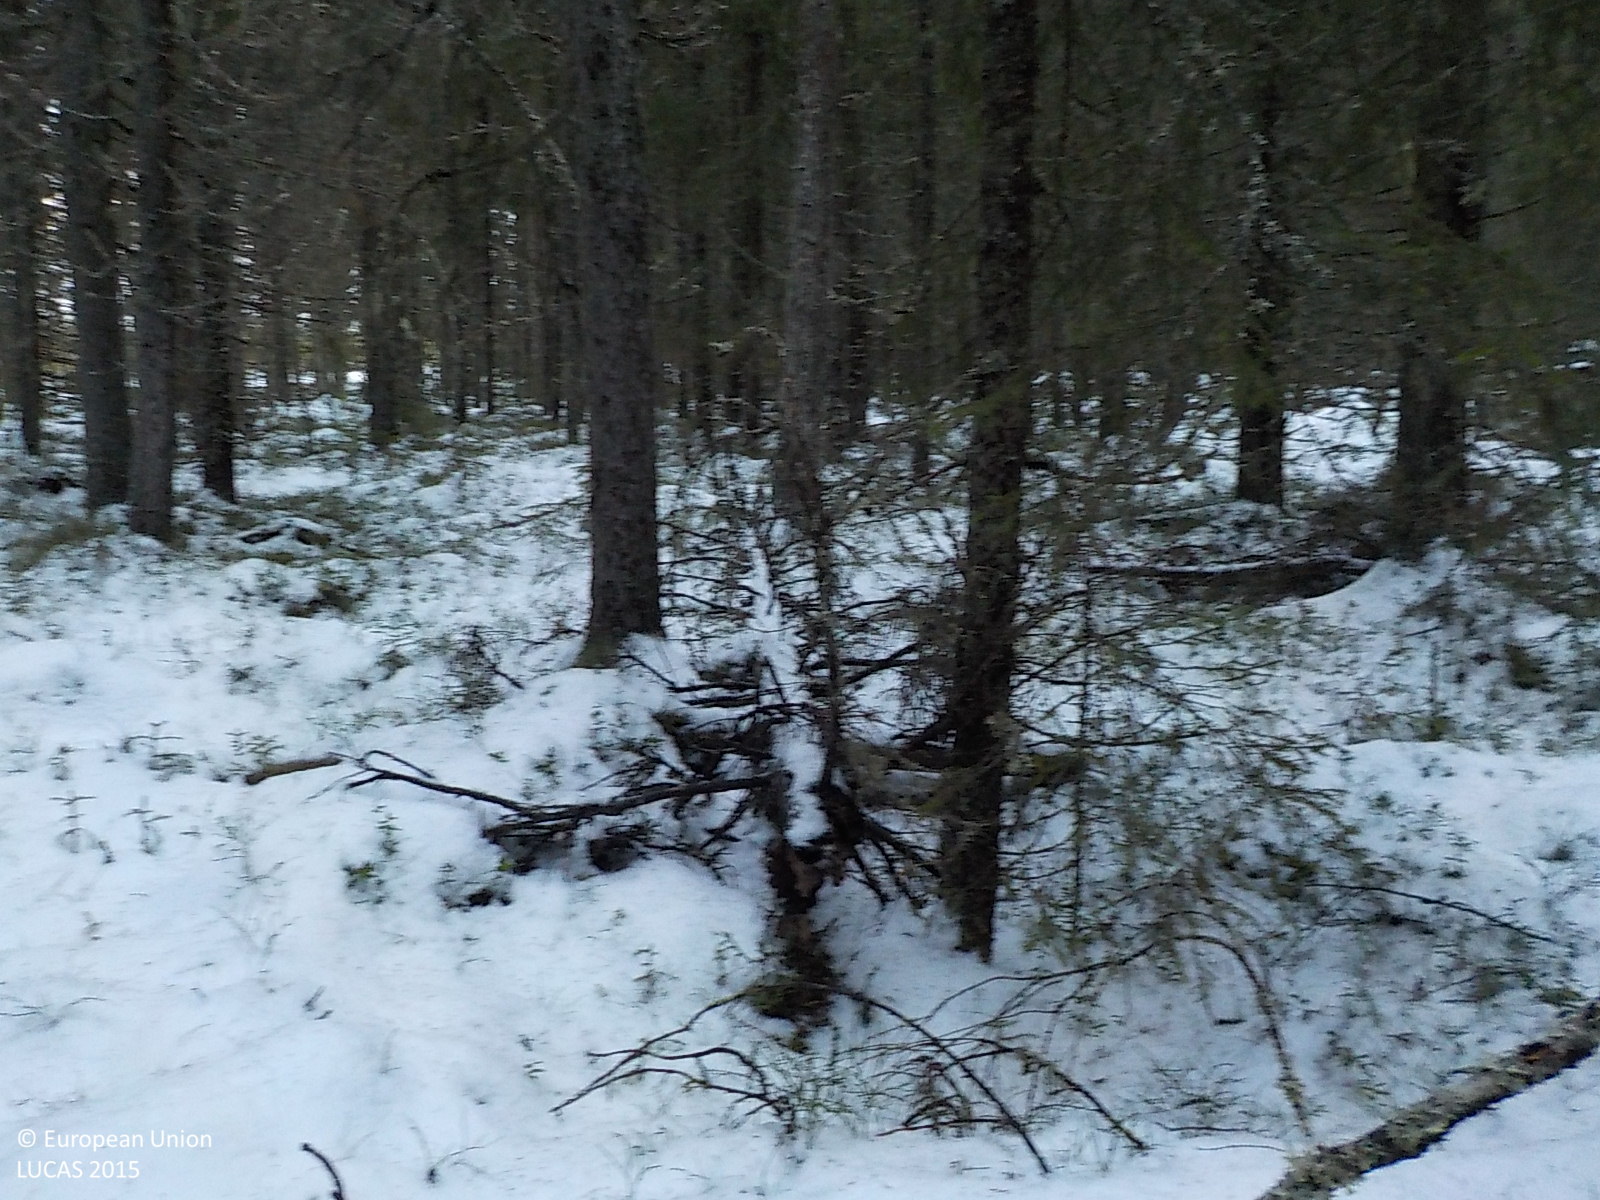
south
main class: Woodland
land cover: Spruce dominated coniferous woodland
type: boreal forest
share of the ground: > 75 %
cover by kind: coniferous forest trees 75 %, shrubs 10 %, broadleaved forest trees 5 %, herbaceous plants 5 %, lichens and mosses 5 %
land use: Forestry
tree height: > 5 m
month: December
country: SE
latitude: 63.5150
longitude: 16.6664
